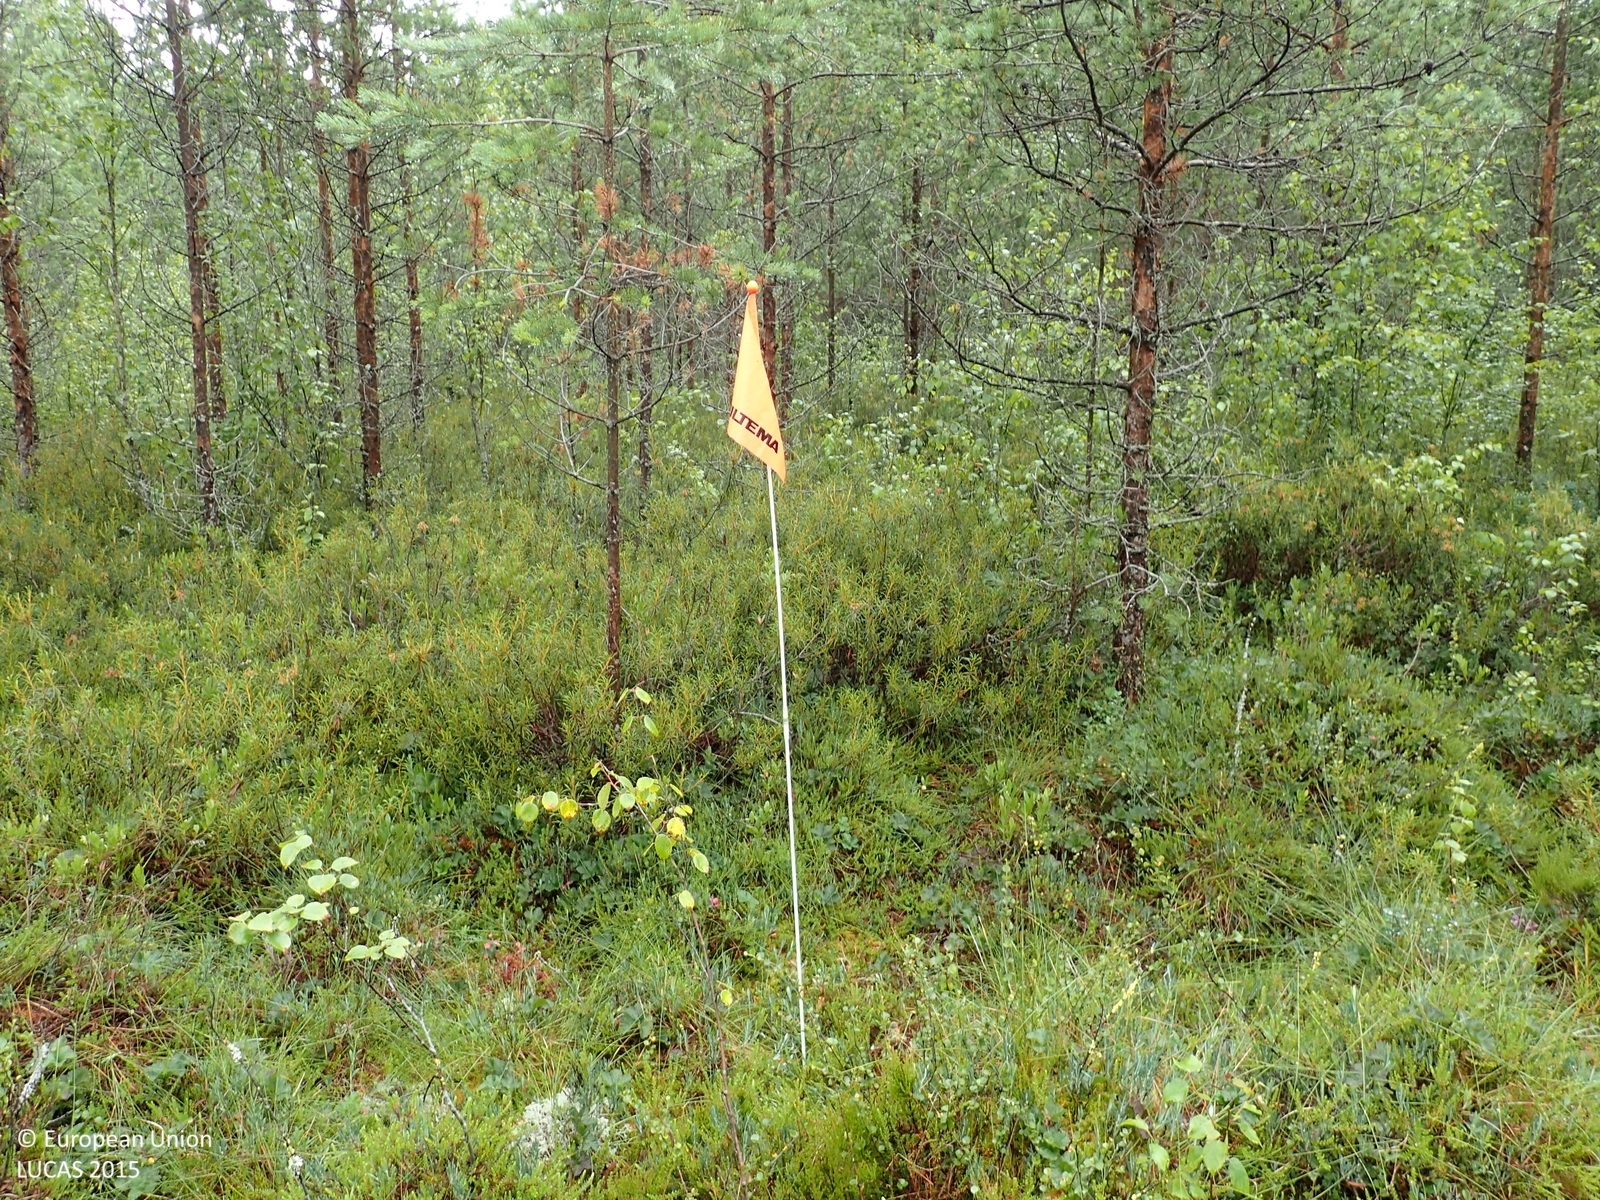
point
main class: Woodland
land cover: Pine dominated coniferous woodland
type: mire and swamp forests
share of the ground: 50 - 75 %
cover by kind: coniferous forest trees 50 %, shrubs 45 %, broadleaved forest trees 5 %
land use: Forestry
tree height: < 5 m
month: July
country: FI
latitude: 63.0127
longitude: 22.8359
